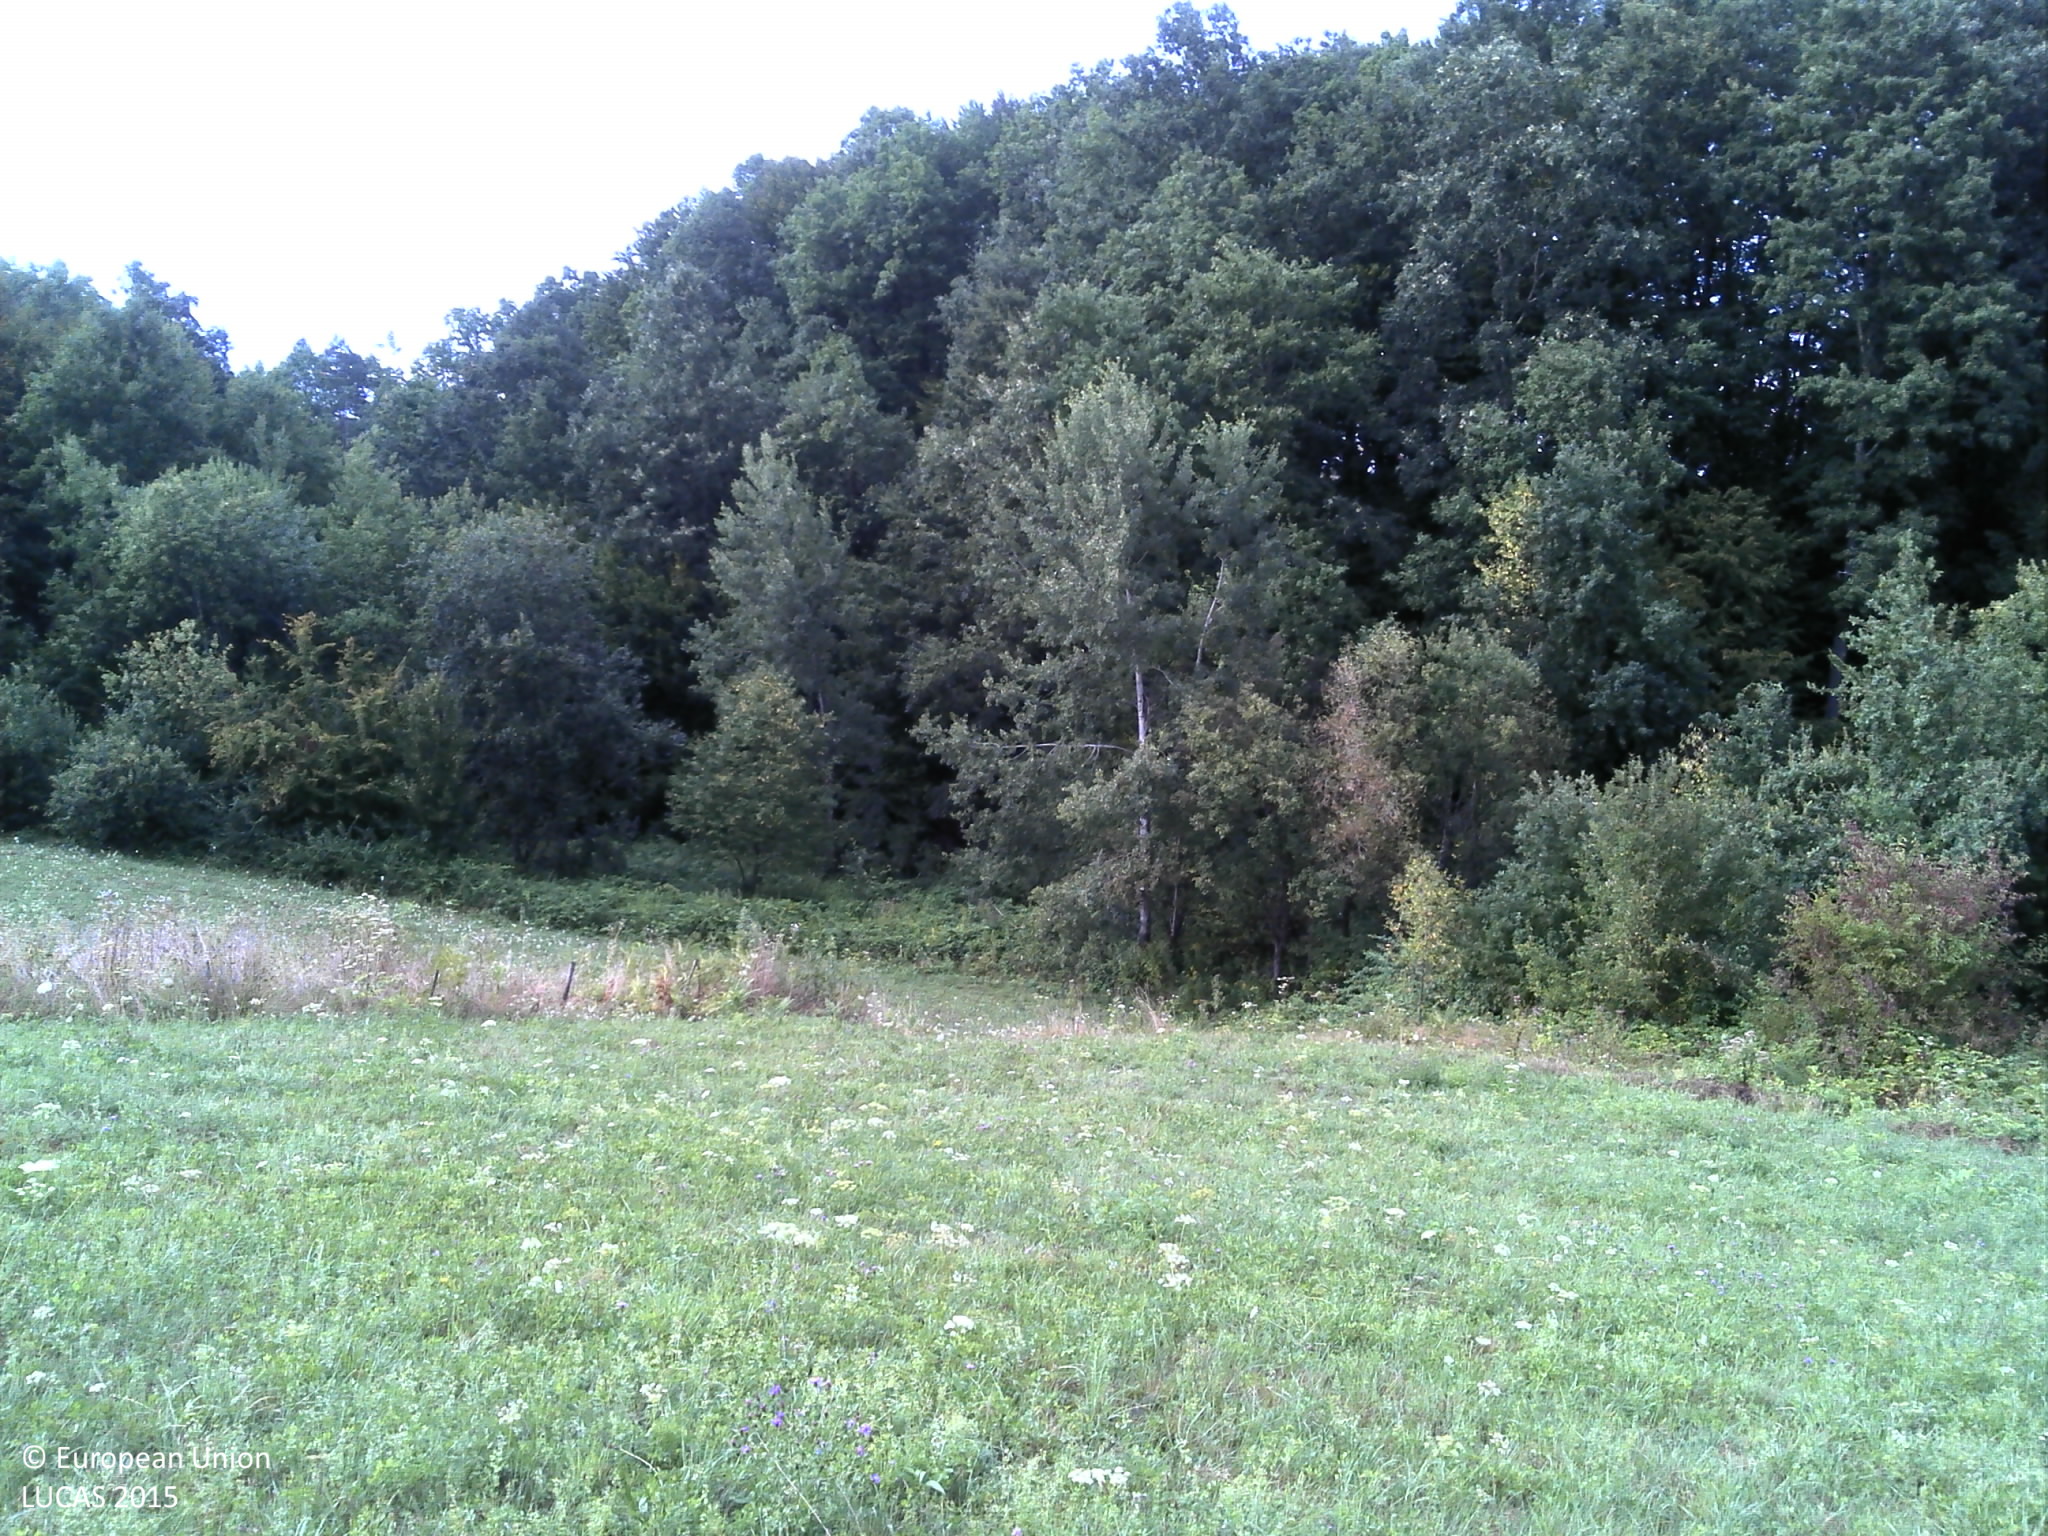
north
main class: Grassland
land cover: Spontaneously vegetated surfaces
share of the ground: > 75 %
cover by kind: herbaceous plants 100 %
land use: Agriculture (excluding fallow land and kitchen gardens)
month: August
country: HR
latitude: 45.4388
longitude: 15.7363
